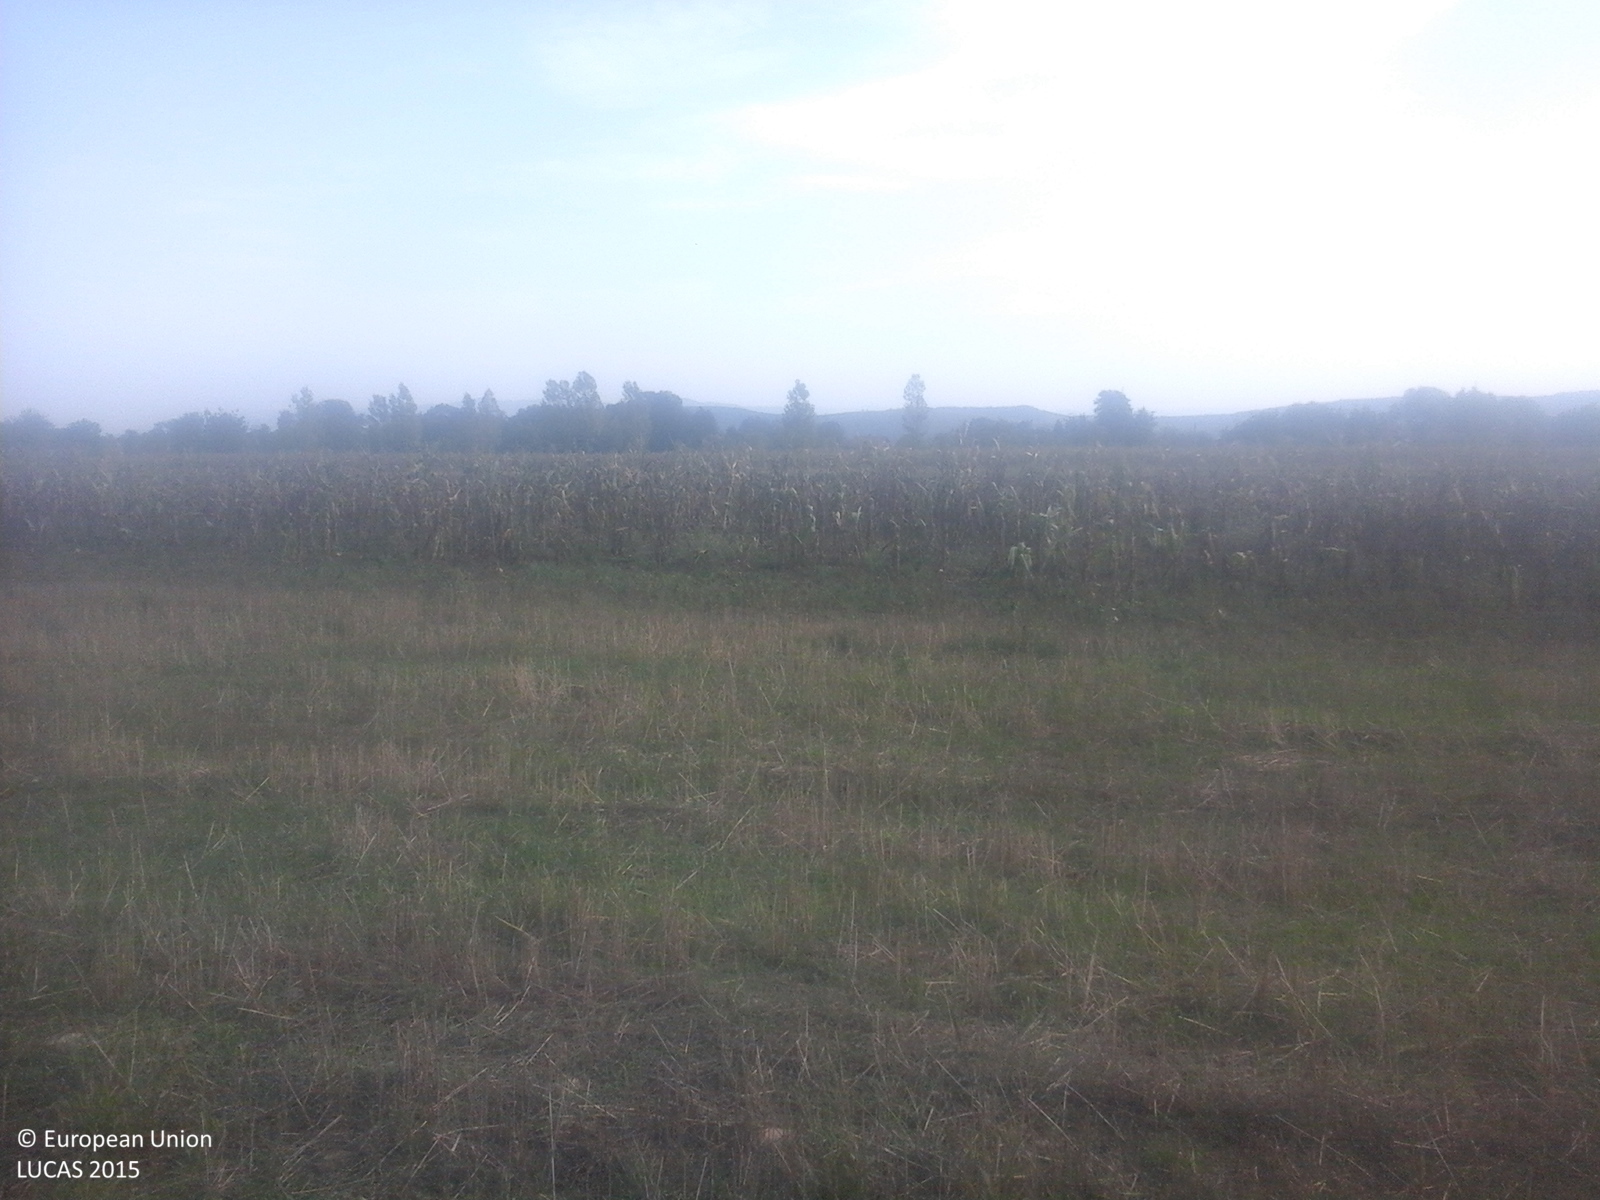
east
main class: Cropland
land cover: Common wheat
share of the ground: 50 - 75 %
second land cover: Spontaneously vegetated surfaces
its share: 50 - 75 %
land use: Agriculture (excluding fallow land and kitchen gardens)
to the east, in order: Common wheat; Spontaneously vegetated surfaces; Maize; Potatoes; Common wheat; Potatoes; Maize; Potatoes; Other bare soil; Tracks; Grass margins; Ditches and canals; Lines of trees; Grass margins; Paved roads, cycling and walking lanes; Shruby margins; Common wheat
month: September
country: RO
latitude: 45.5189
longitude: 22.8396
